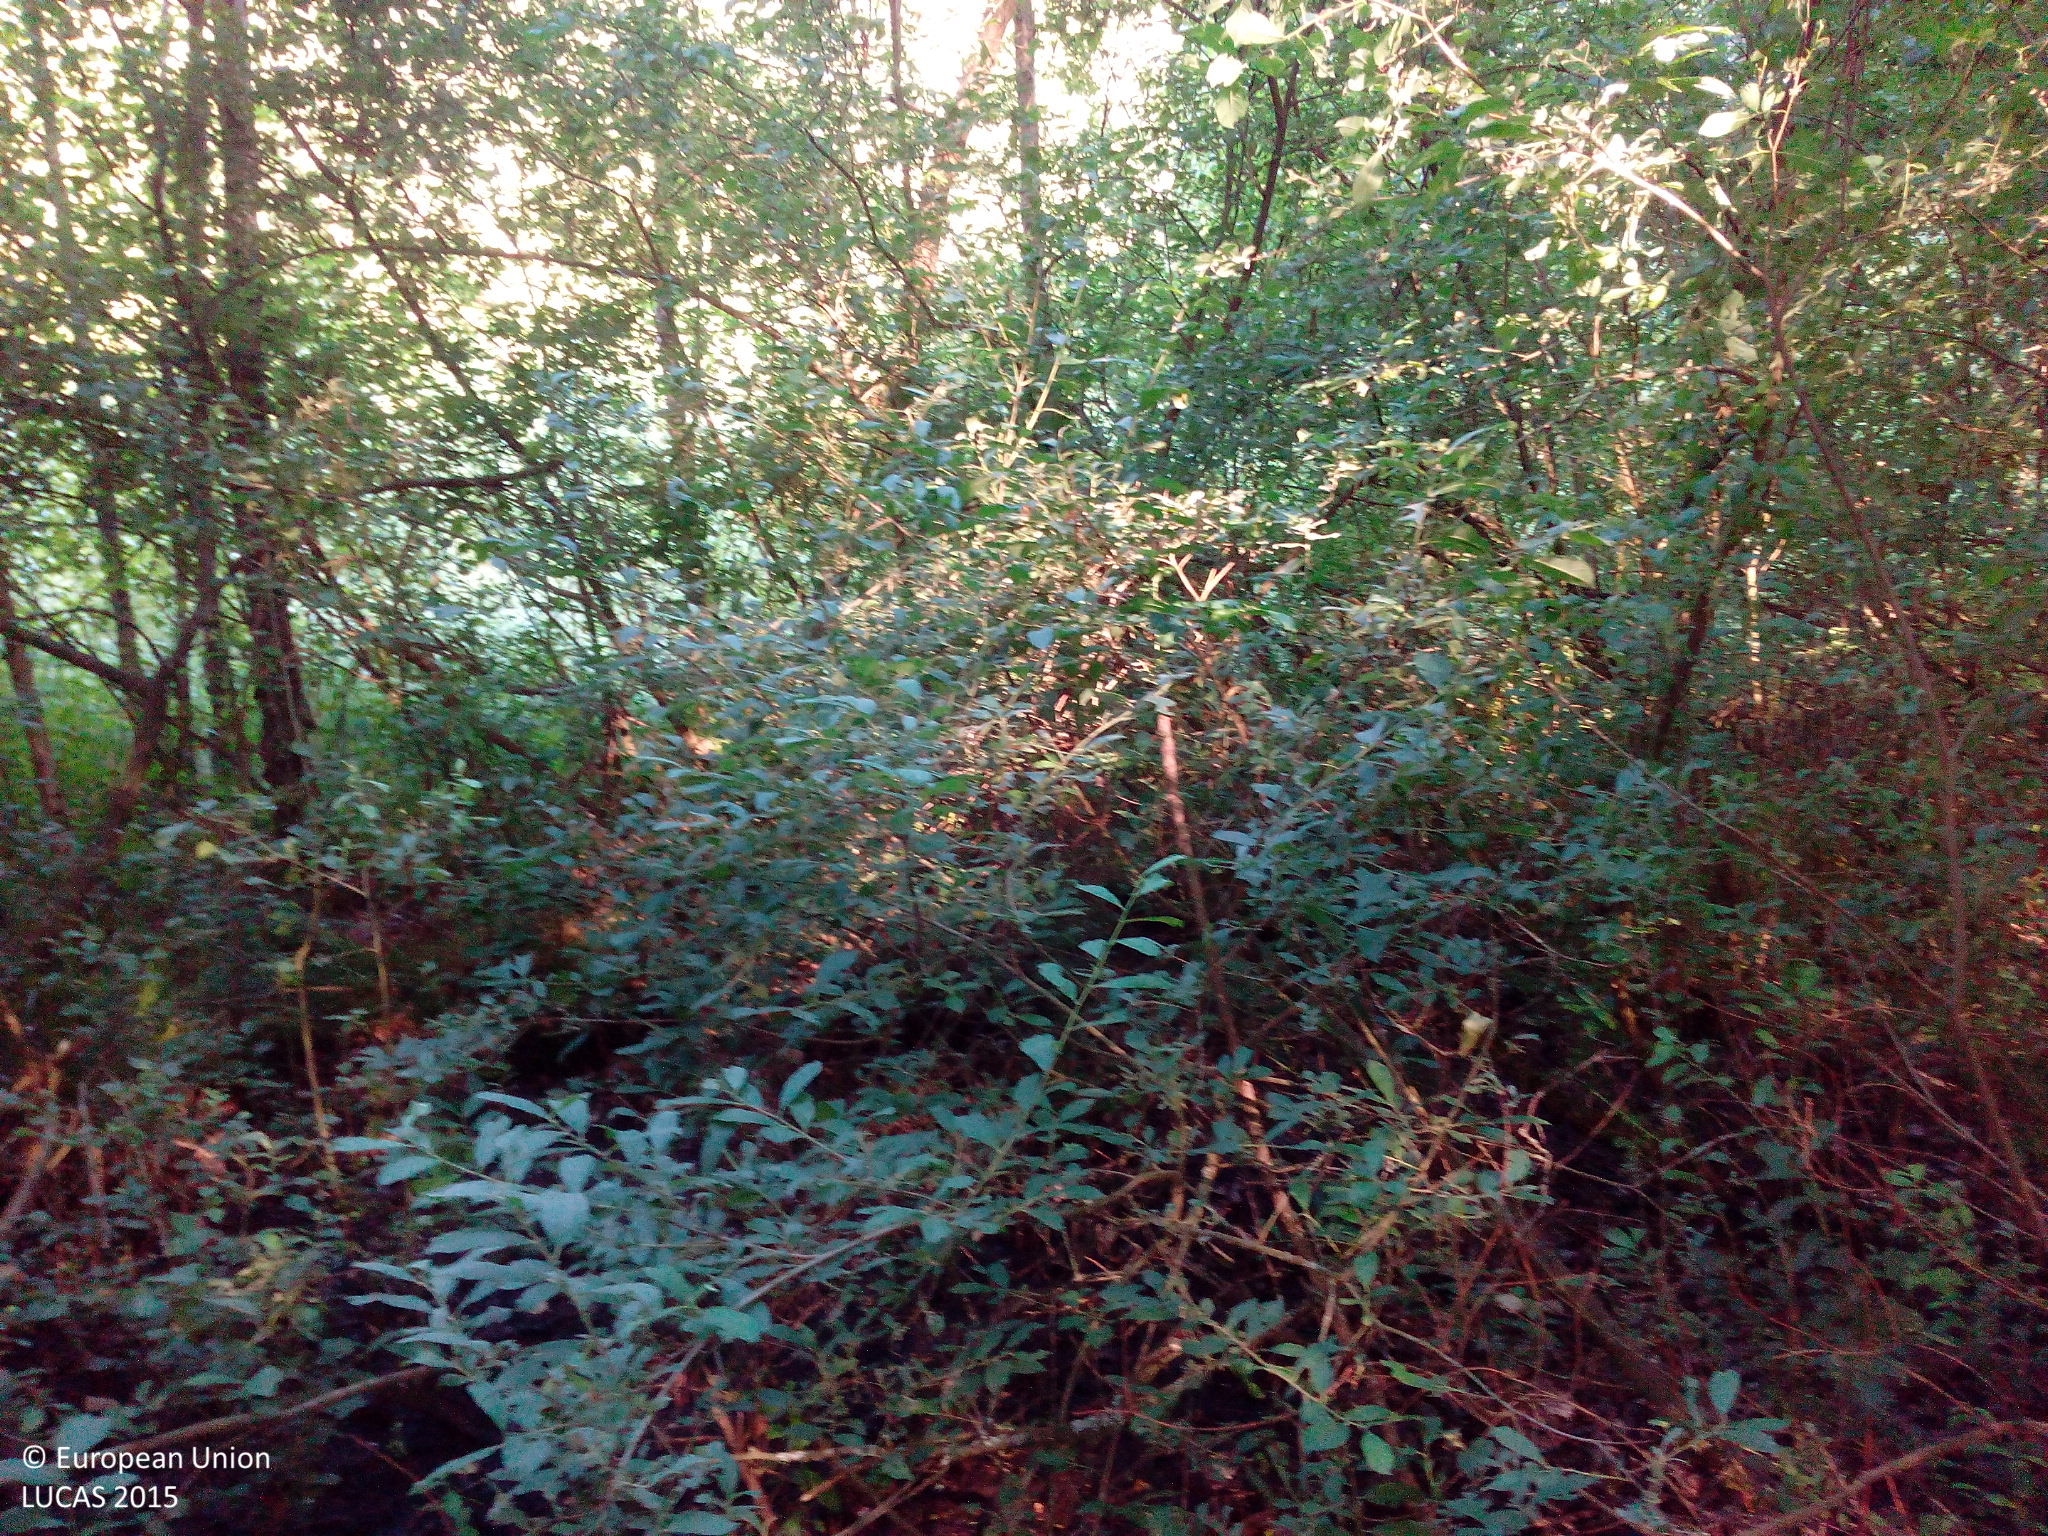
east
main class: Woodland
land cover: Broadleaved woodland
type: mire and swamp forests
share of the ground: > 75 %
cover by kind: broadleaved forest trees 95 %, herbaceous plants 5 %
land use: Semi-natural and natural areas not in use
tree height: > 5 m
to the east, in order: Broadleaved woodland; Tracks; Broadleaved woodland
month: July
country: DE
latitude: 49.7705
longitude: 9.8473
